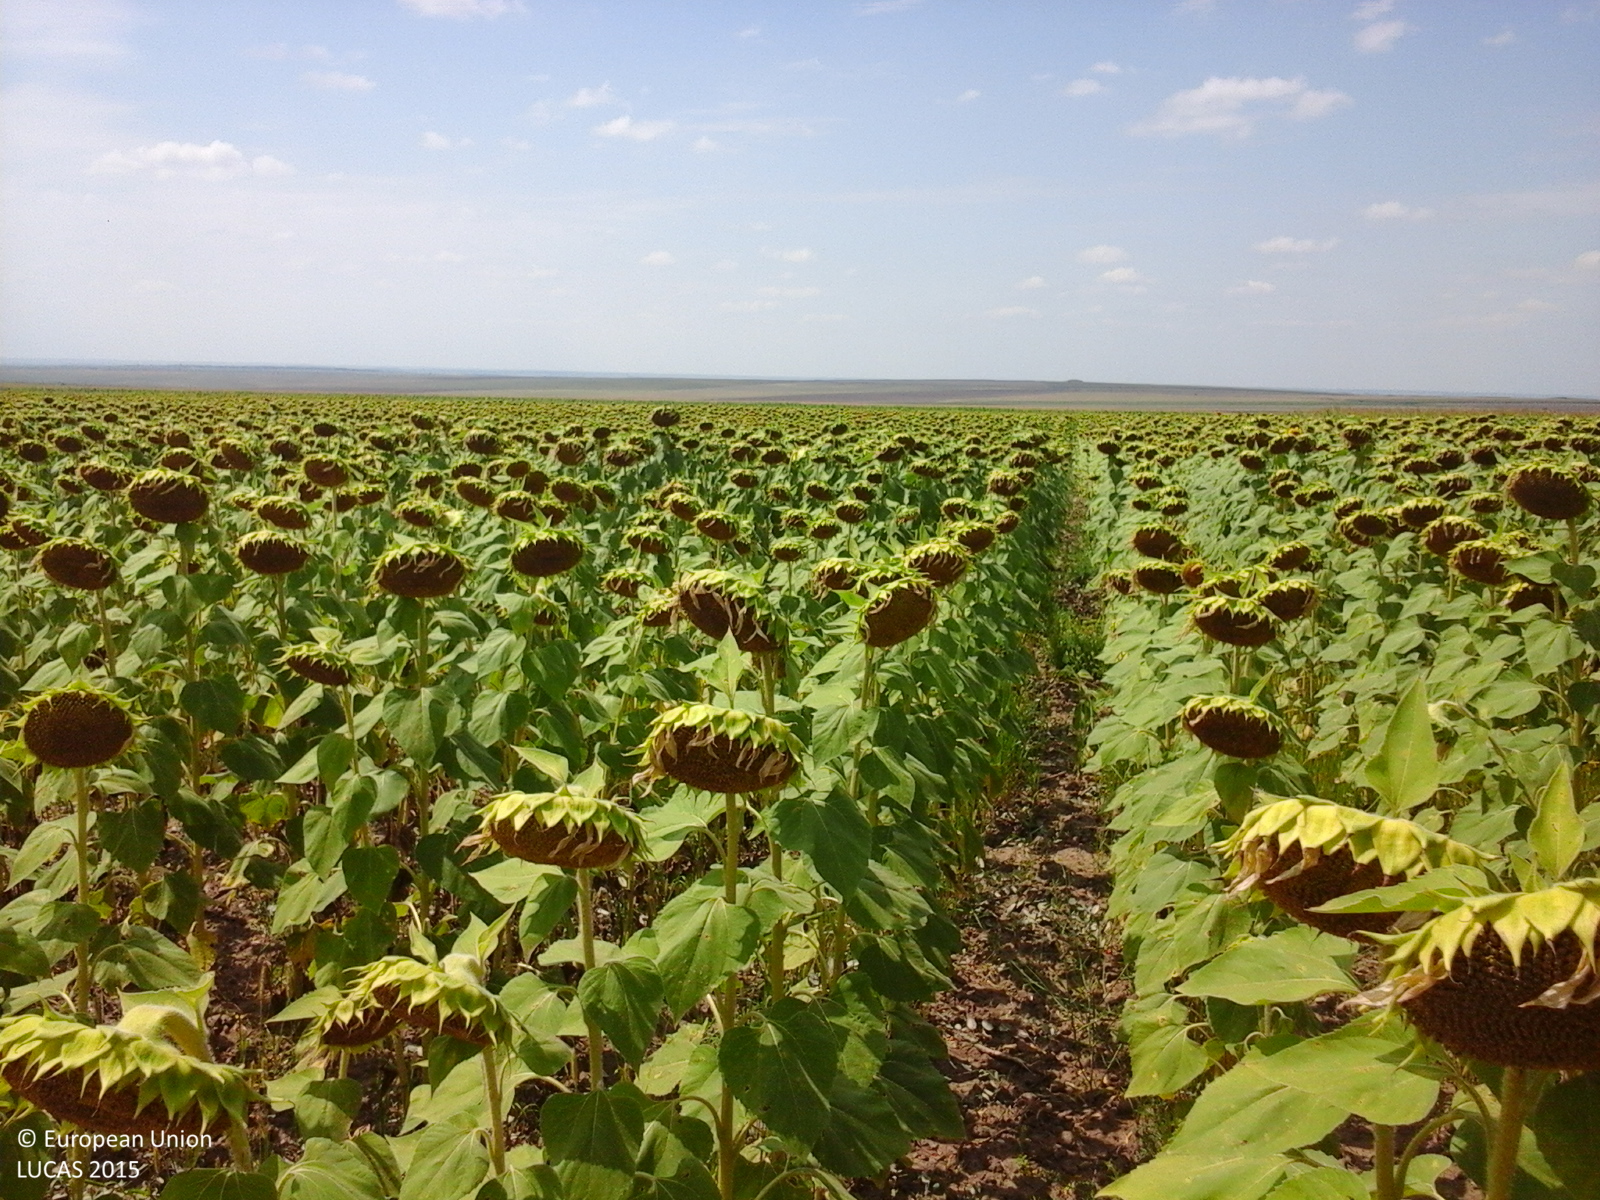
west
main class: Cropland
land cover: Sunflower
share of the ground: > 75 %
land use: Agriculture (excluding fallow land and kitchen gardens)
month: August
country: RO
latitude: 44.8076
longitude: 28.2105
